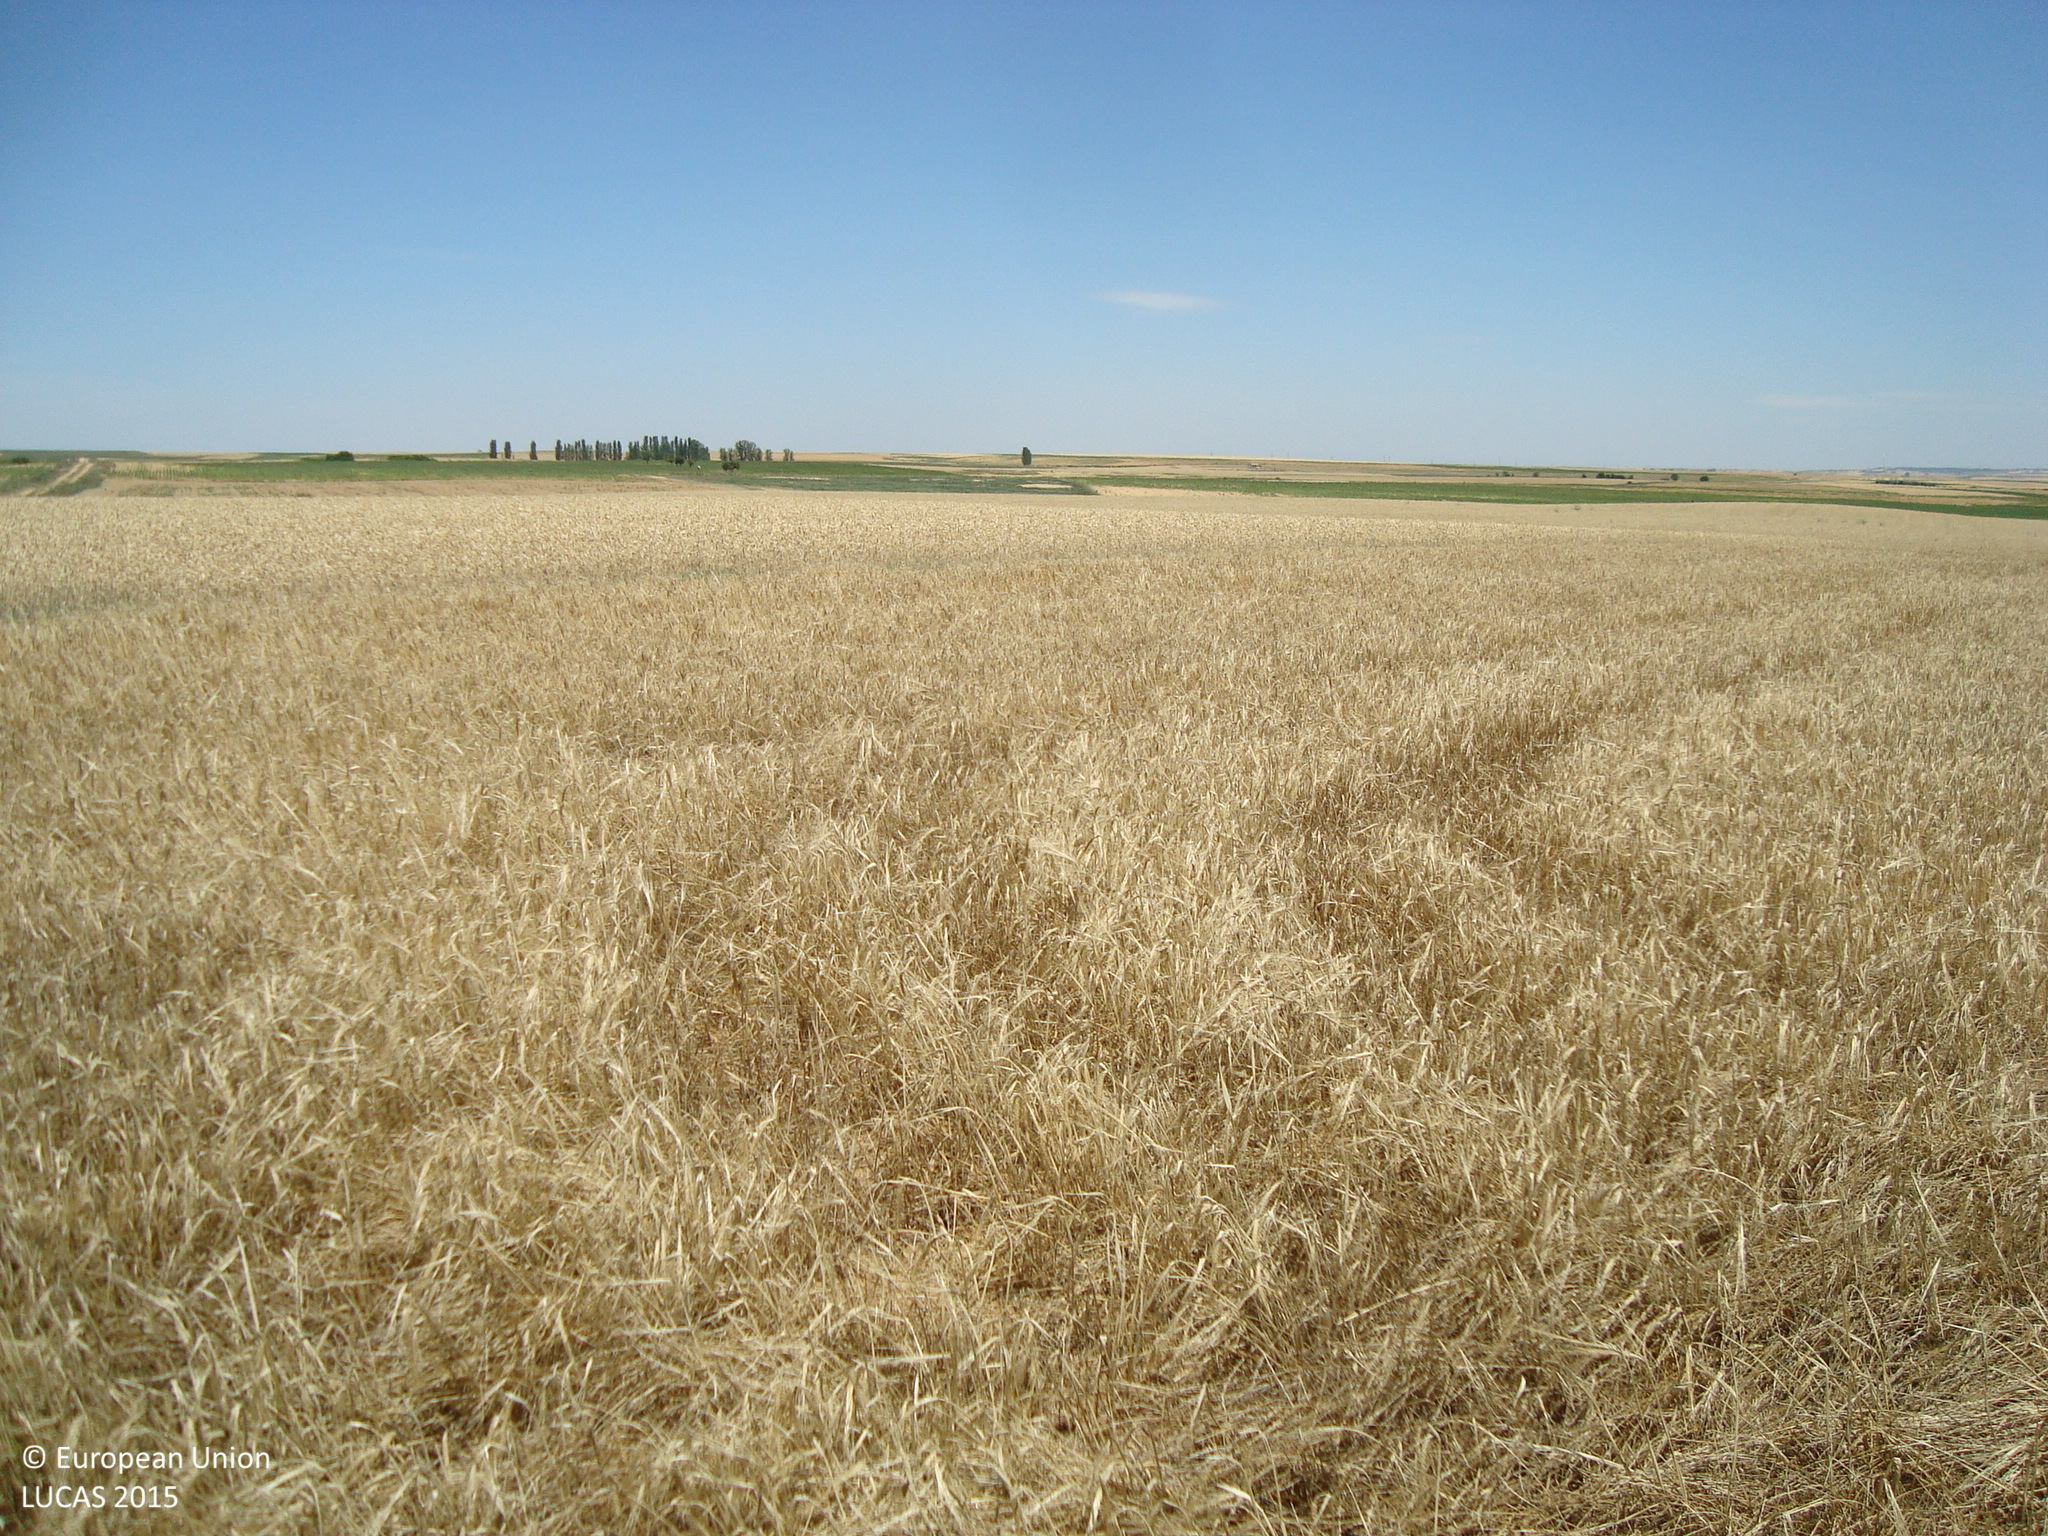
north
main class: Cropland
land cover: Barley
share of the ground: > 75 %
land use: Agriculture (excluding fallow land and kitchen gardens)
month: July
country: ES
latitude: 42.1283
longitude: -4.7985
